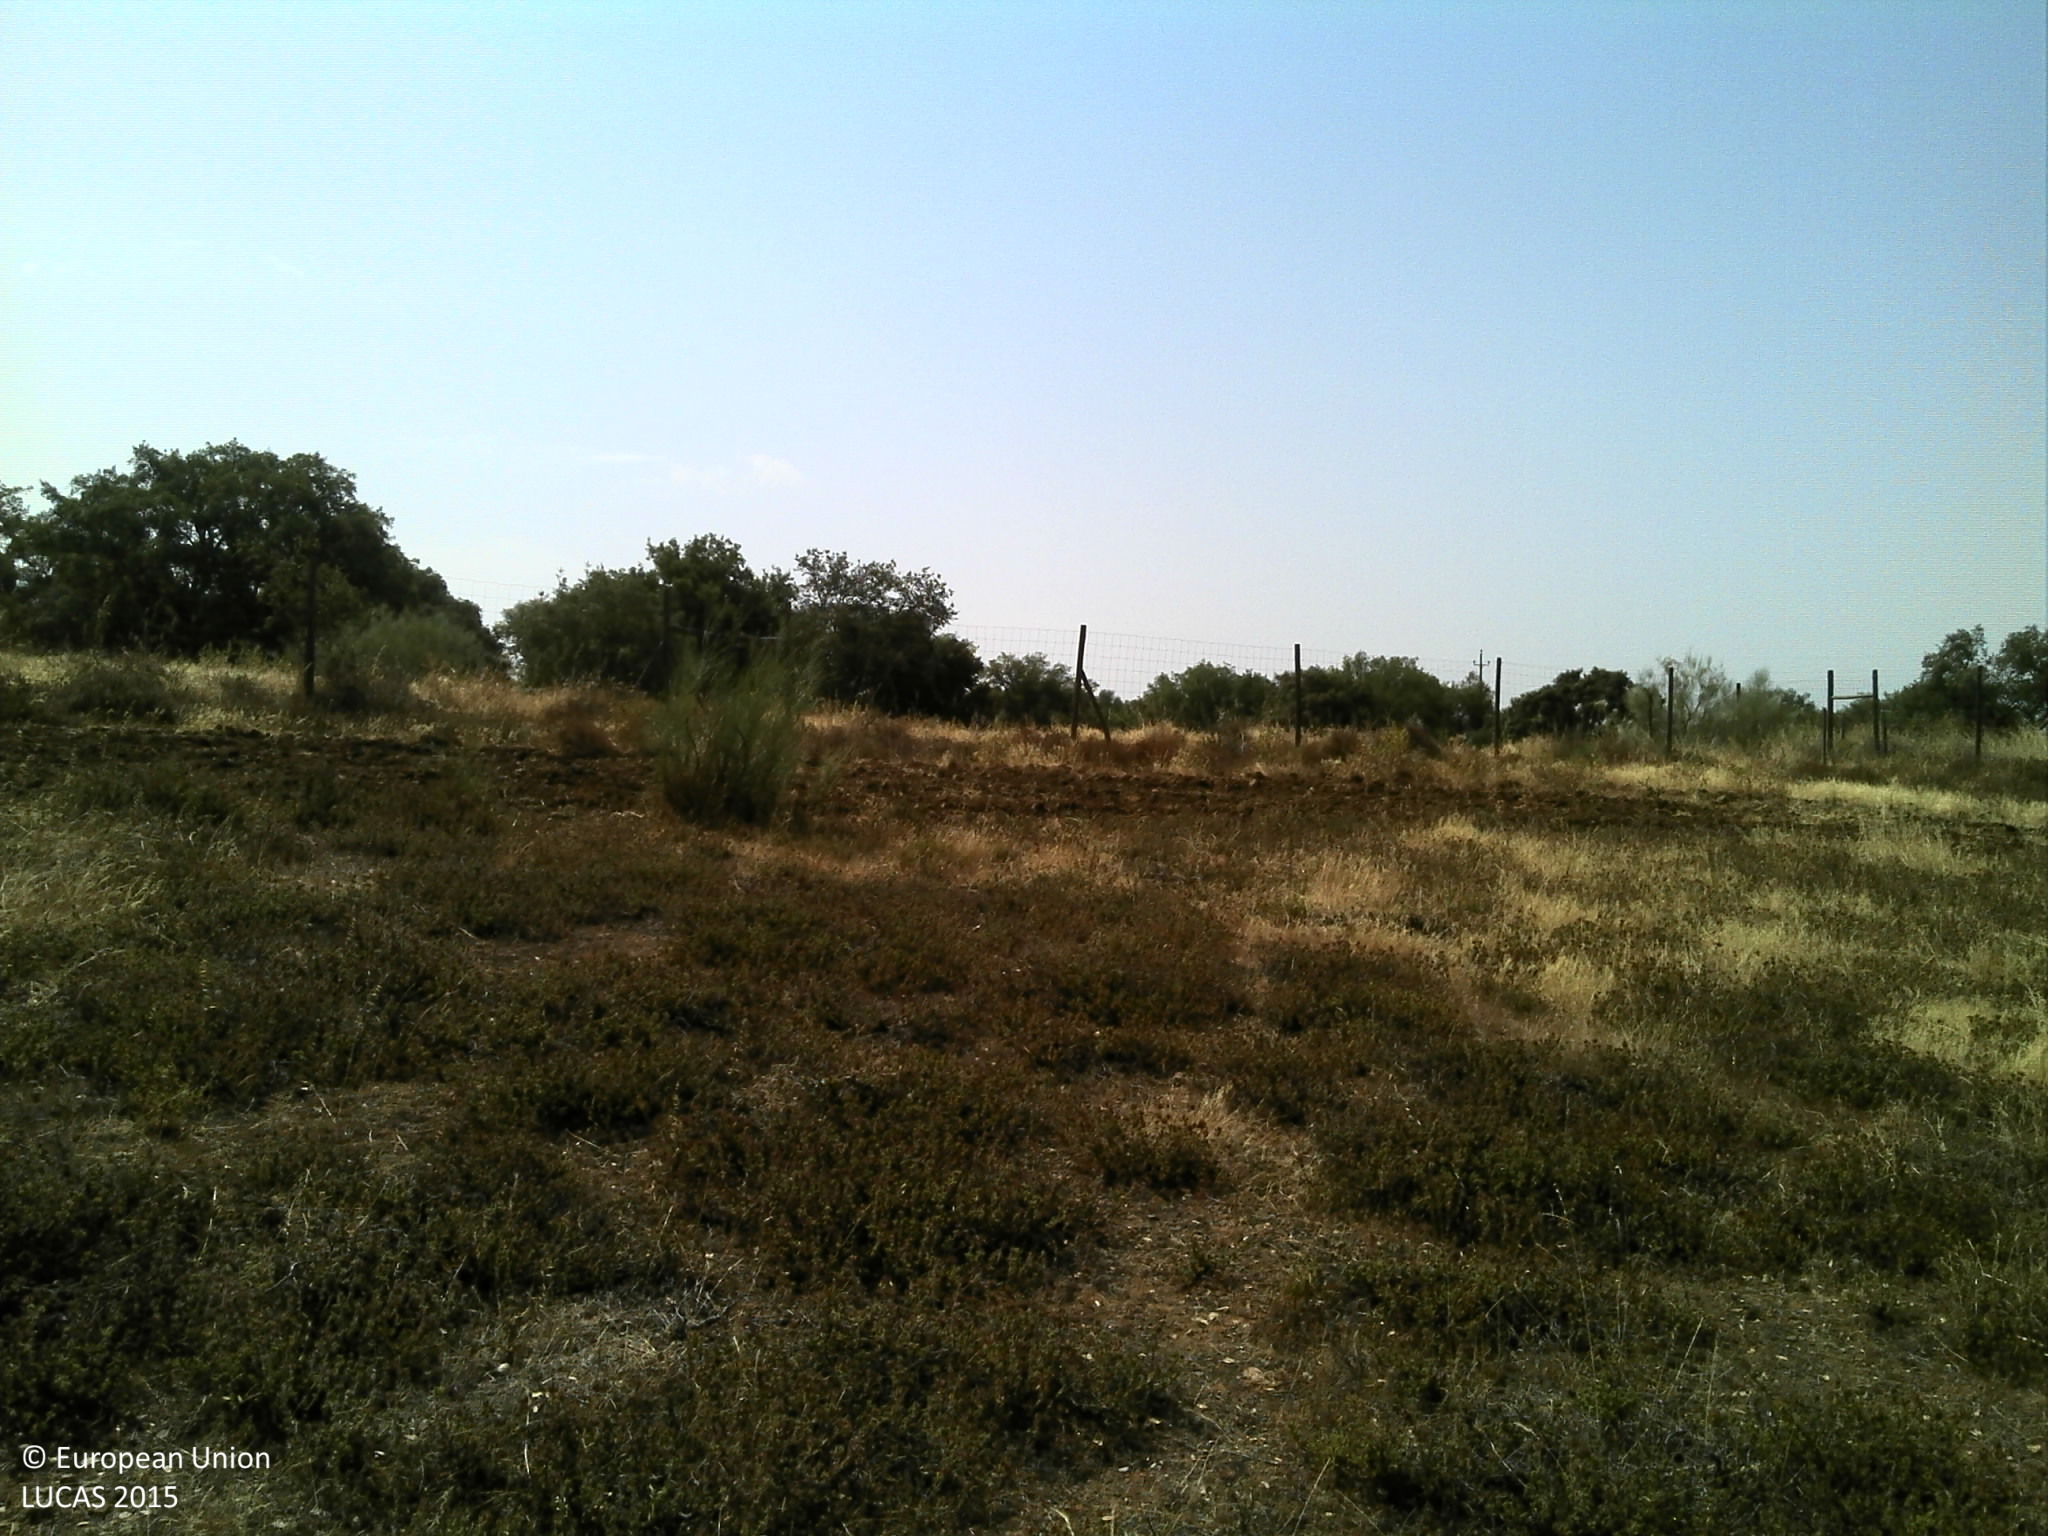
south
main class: Woodland
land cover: Broadleaved woodland
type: broadleaved evergreen forest
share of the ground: 10 - 25 %
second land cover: Grassland without tree/shrub cover
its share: 10 - 25 %
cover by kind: unconsolidated bare surface 70 %, broadleaved forest trees 15 %, herbaceous plants 15 %
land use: Forestry
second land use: Agriculture (excluding fallow land and kitchen gardens)
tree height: > 5 m
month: July
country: PT
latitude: 38.7247
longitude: -7.8582
